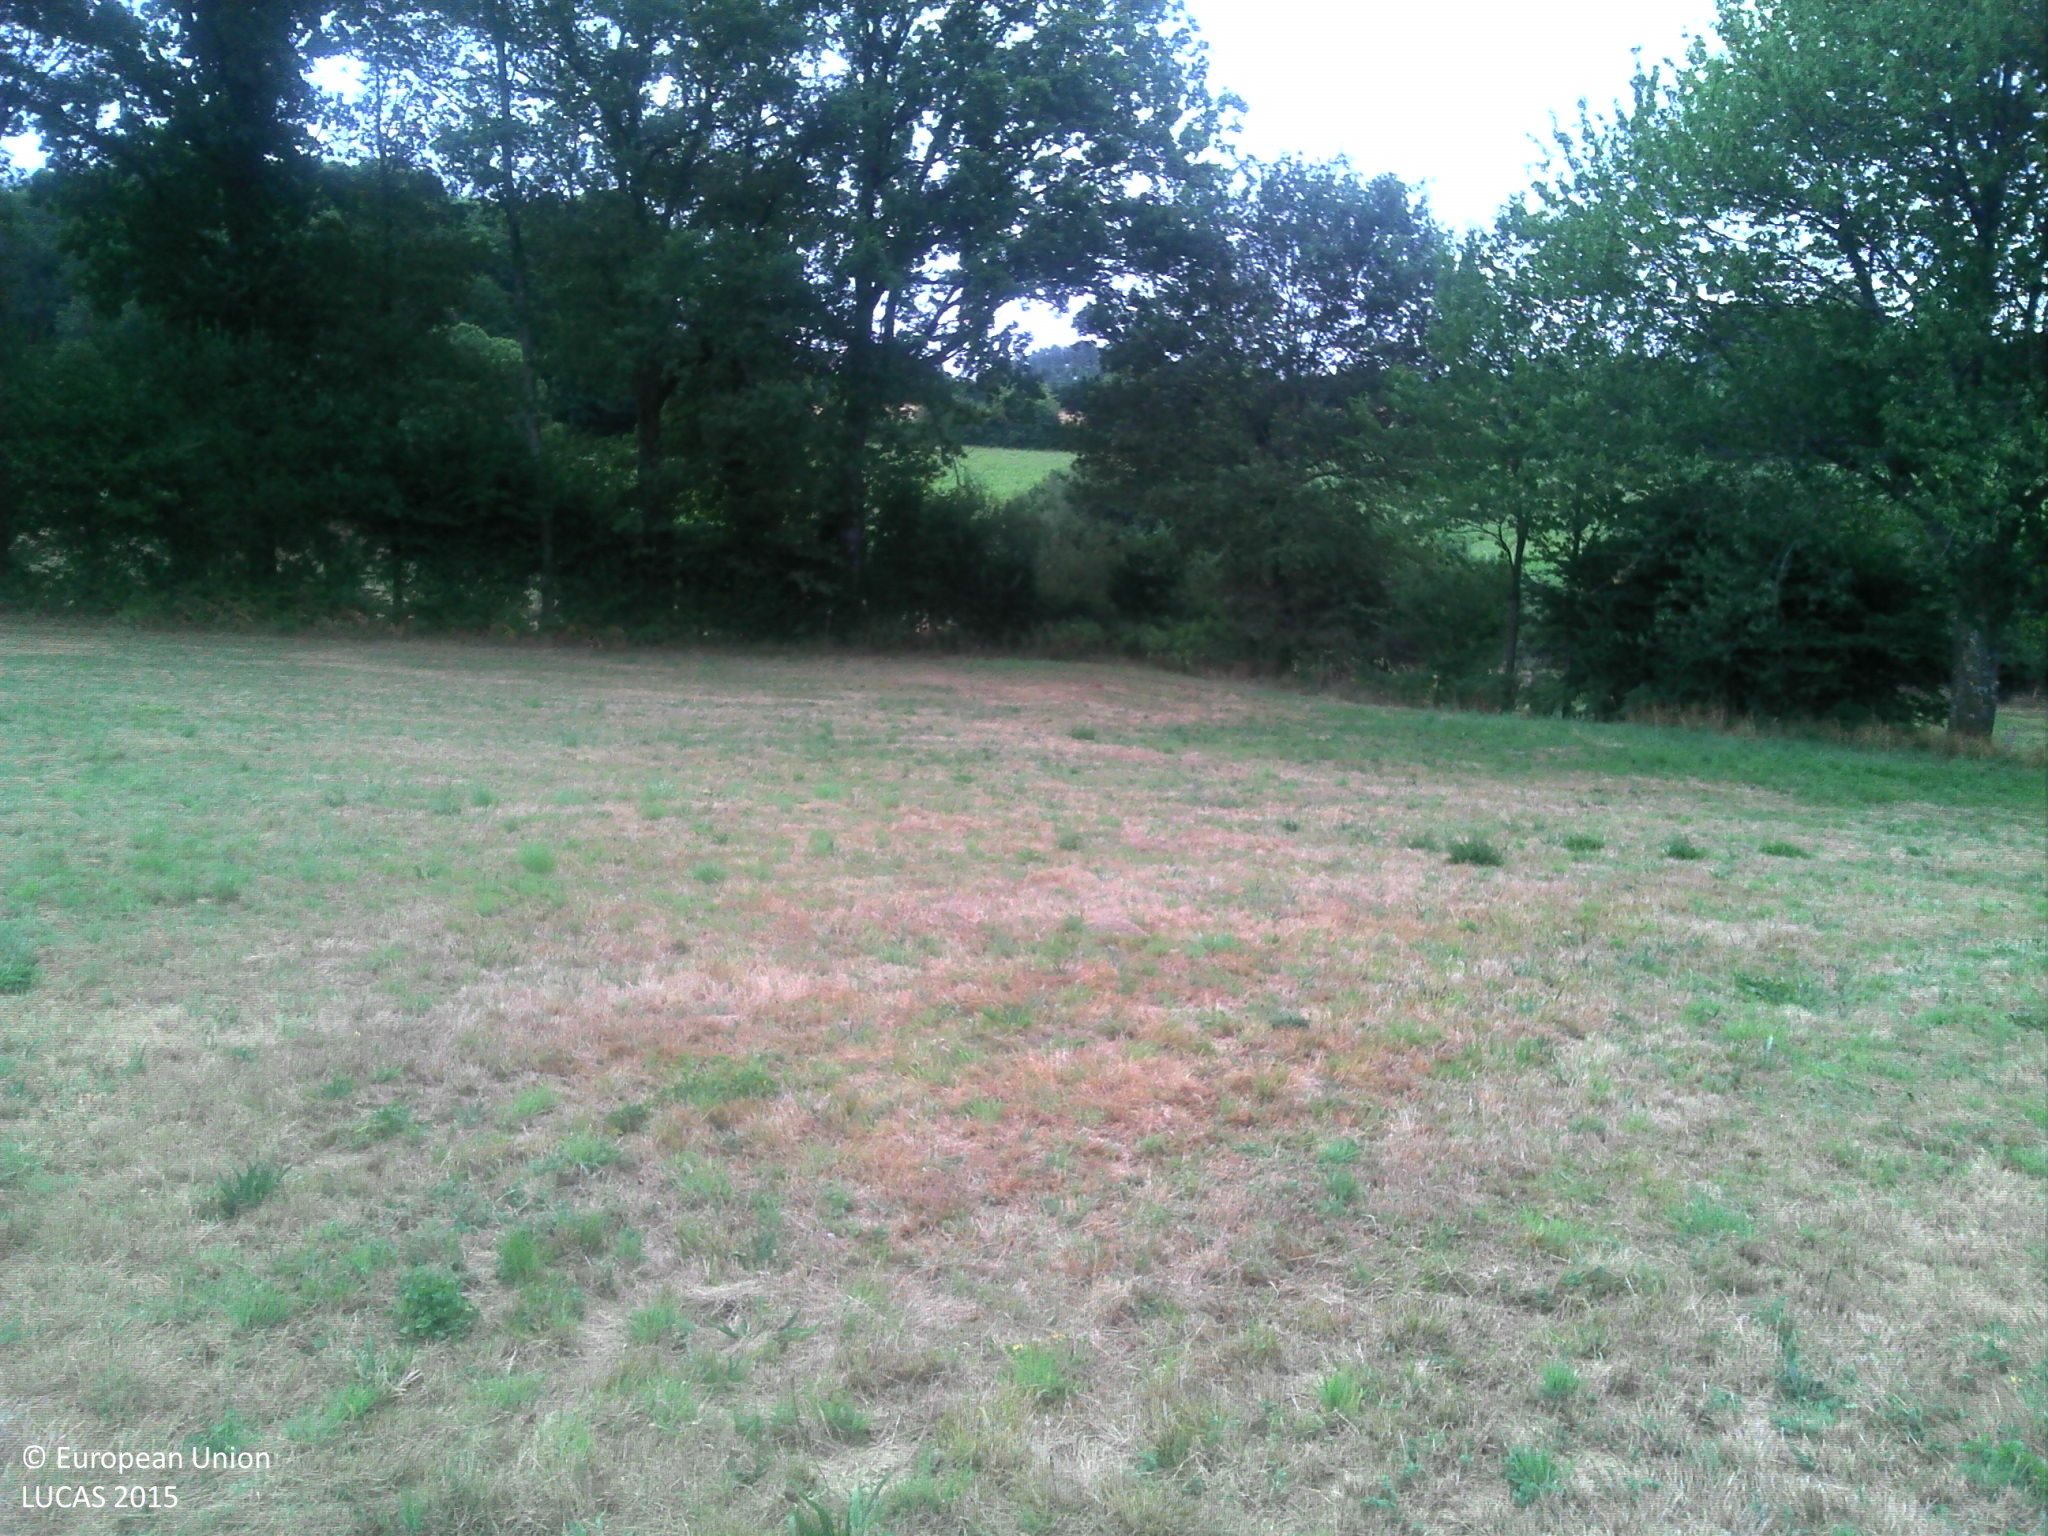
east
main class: Grassland
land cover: Grassland without tree/shrub cover
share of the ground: > 75 %
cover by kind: herbaceous plants 95 %, shrubs 5 %
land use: Agriculture (excluding fallow land and kitchen gardens)
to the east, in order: Grassland without tree/shrub cover; Lines of trees; Fences; Grassland without tree/shrub cover; Fences; Rivers and streams; Lines of trees; Grassland without tree/shrub cover; Electric lines; Grassland without tree/shrub cover; Fences; Broadleaved woodland
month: July
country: FR
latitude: 45.3966
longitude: 1.4992
